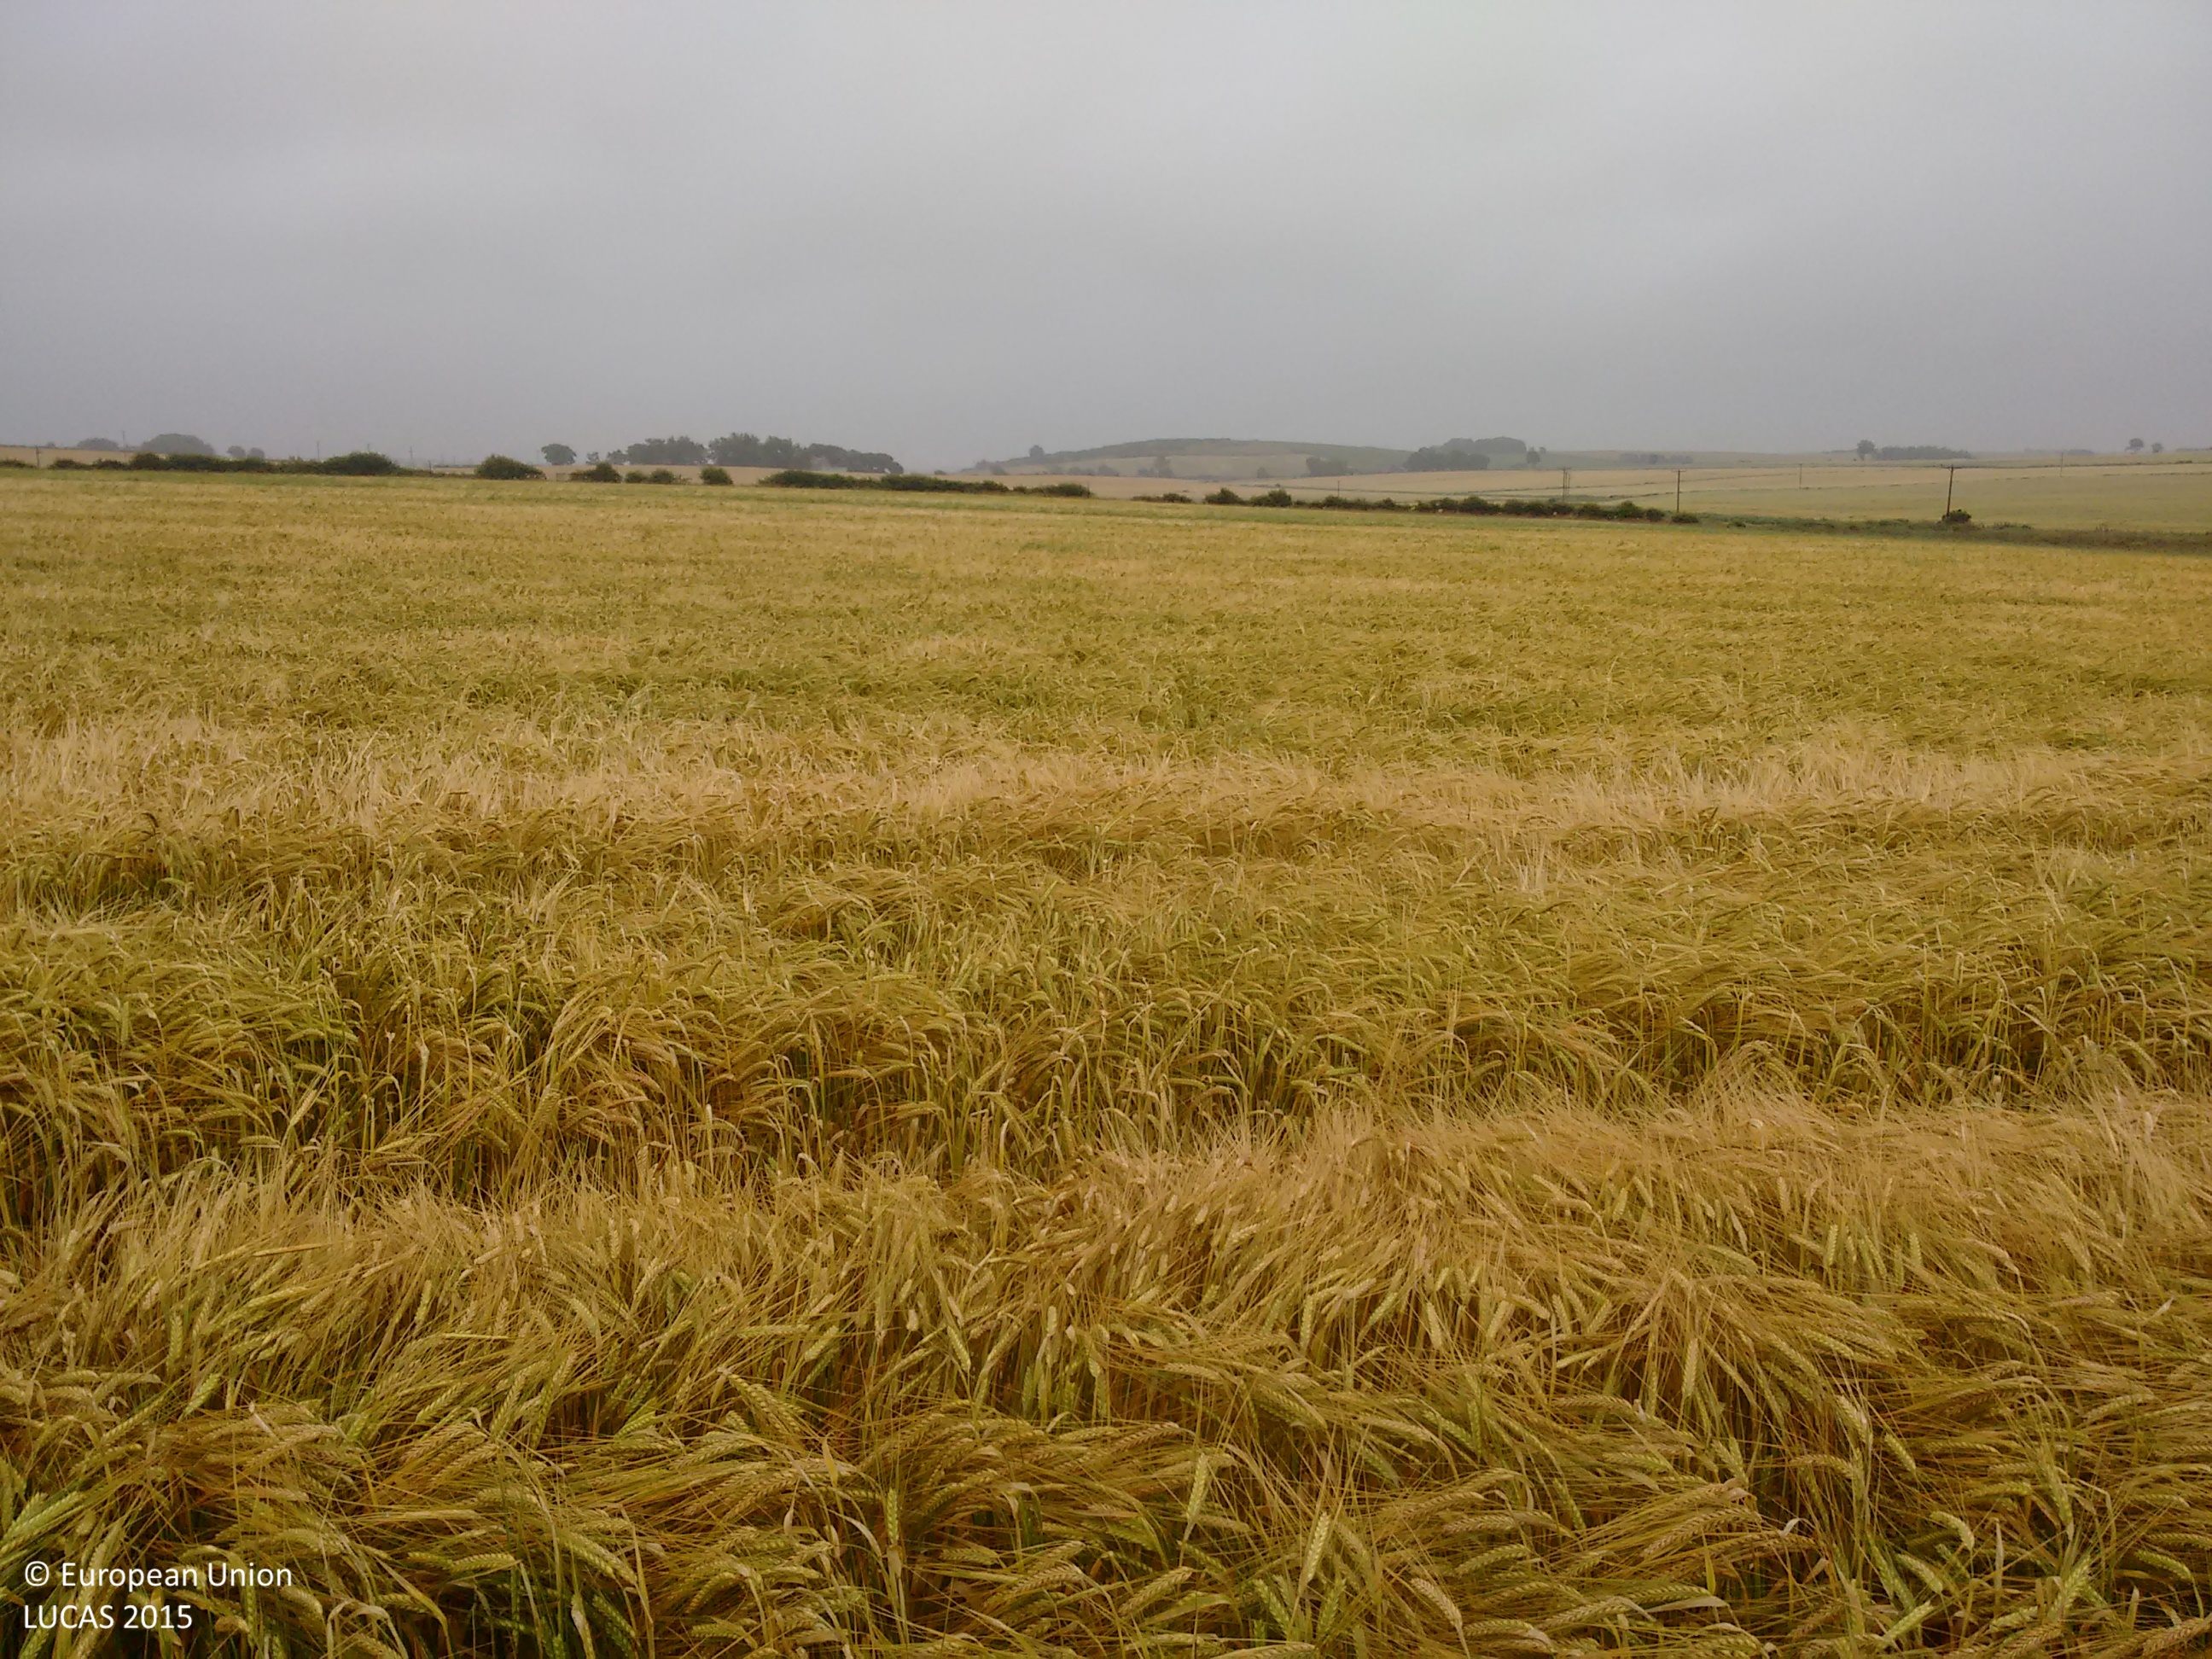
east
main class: Cropland
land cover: Barley
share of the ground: > 75 %
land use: Agriculture (excluding fallow land and kitchen gardens)
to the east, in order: Barley; Fences; Abandoned hedges; Ditches and canals; Abandoned hedges; Fences; Common wheat
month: August
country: GB
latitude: 57.3047
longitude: -2.1149
